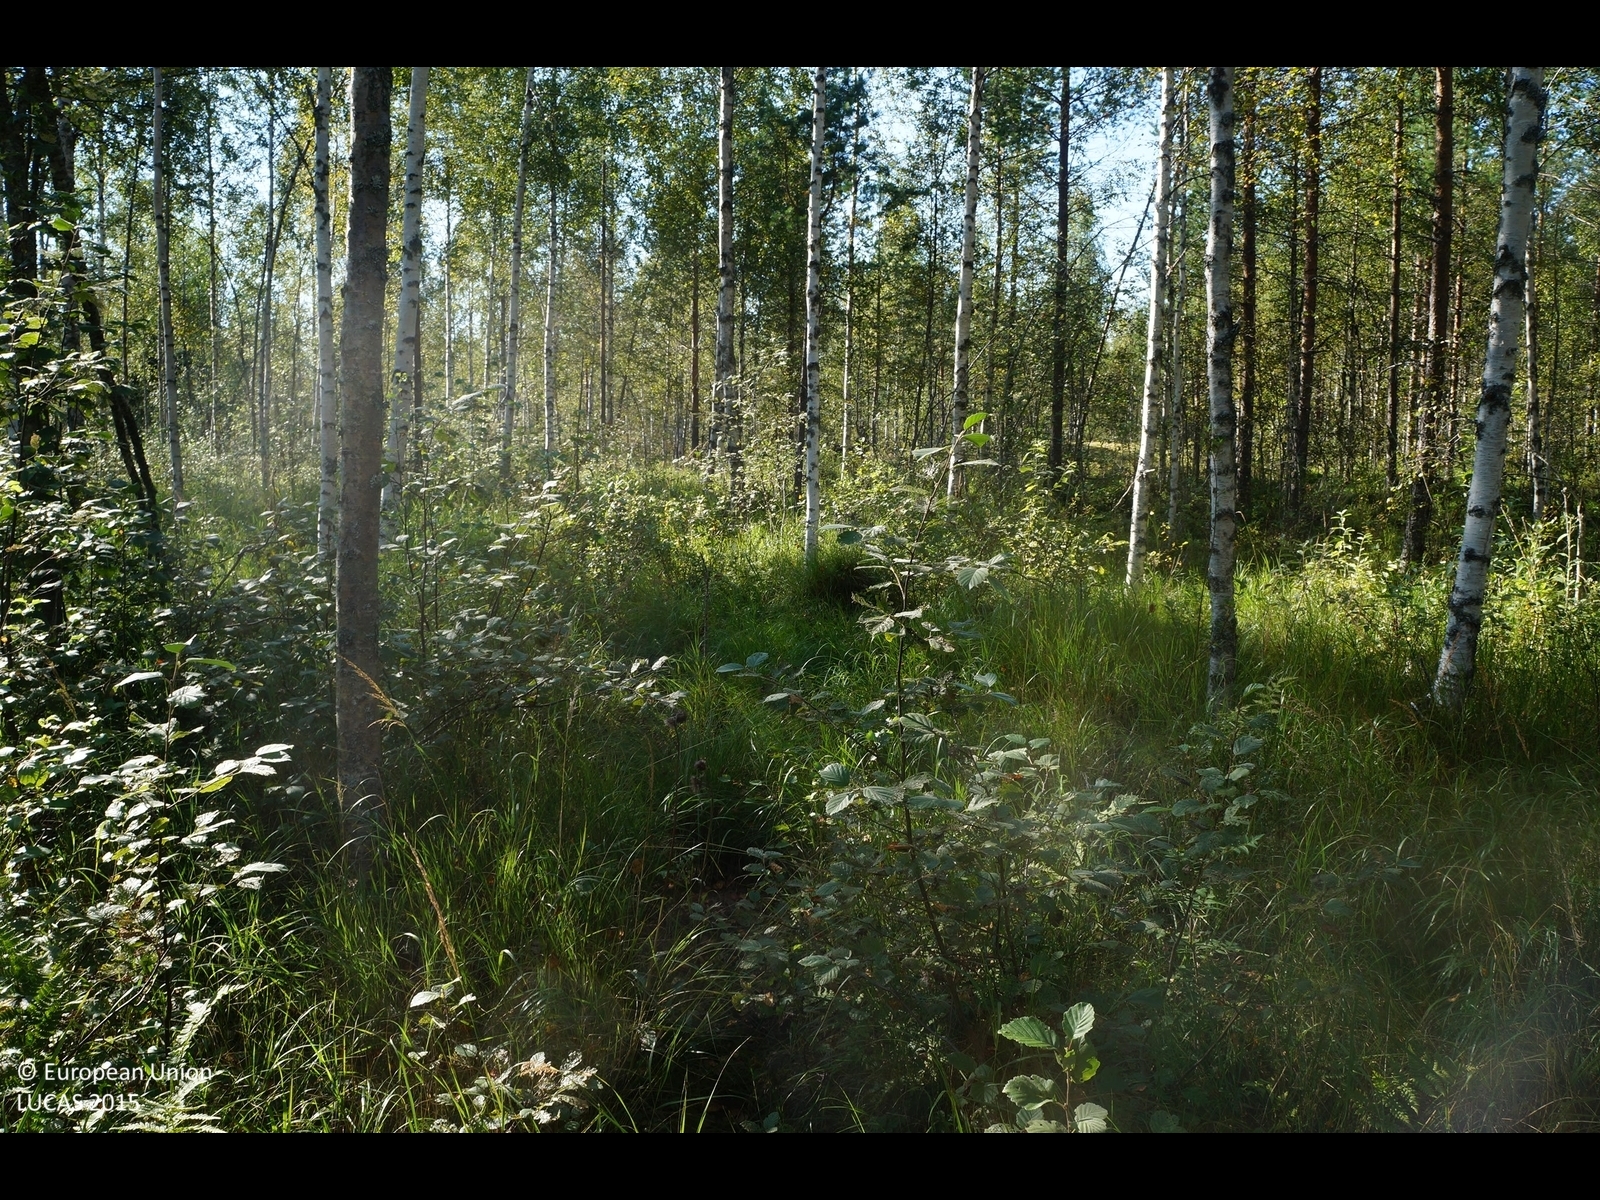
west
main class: Woodland
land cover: Broadleaved woodland
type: non-riverine alder, birch or aspen forest
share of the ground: 25 - 50 %
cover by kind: broadleaved forest trees 40 %, herbaceous plants 40 %, shrubs 20 %
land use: Forestry
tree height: > 5 m
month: August
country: FI
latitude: 64.0861
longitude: 24.9937
